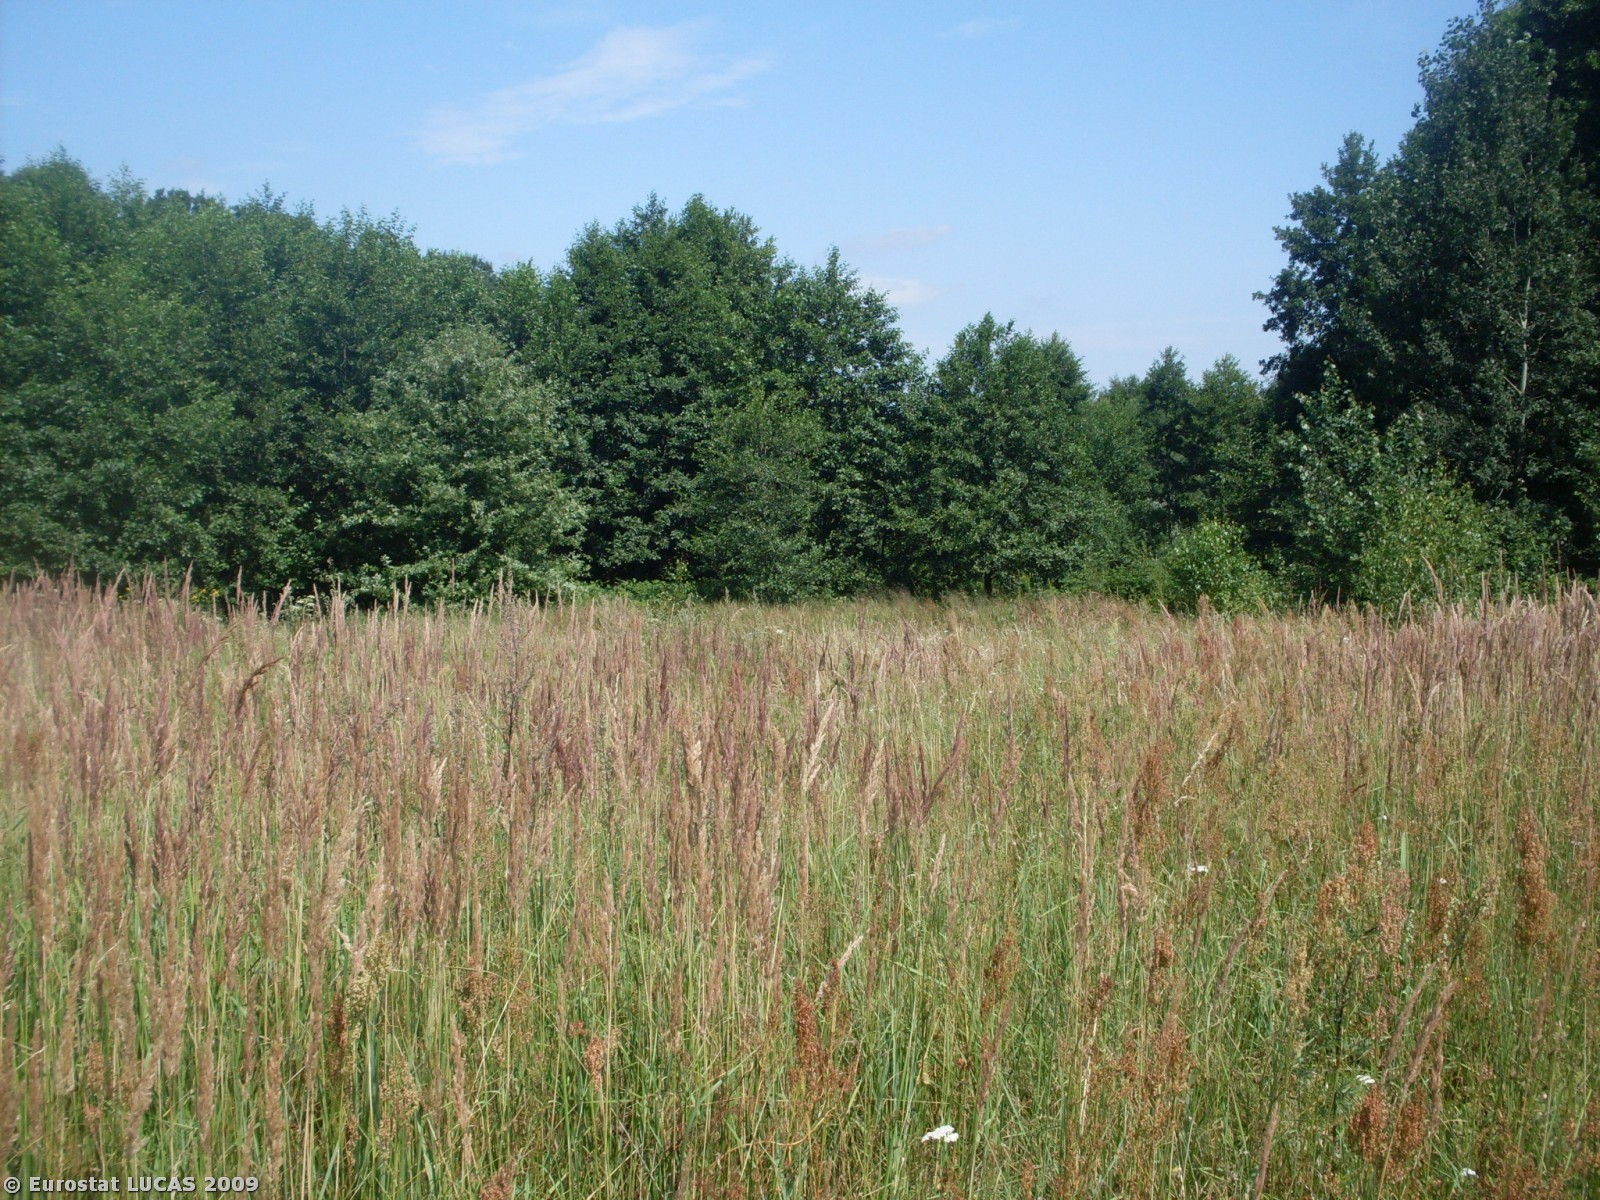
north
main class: Grassland
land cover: Grassland without tree/shrub cover
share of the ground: > 75 %
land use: Agriculture (excluding fallow land and kitchen gardens)
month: August
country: PL
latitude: 49.9793
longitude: 20.5951
